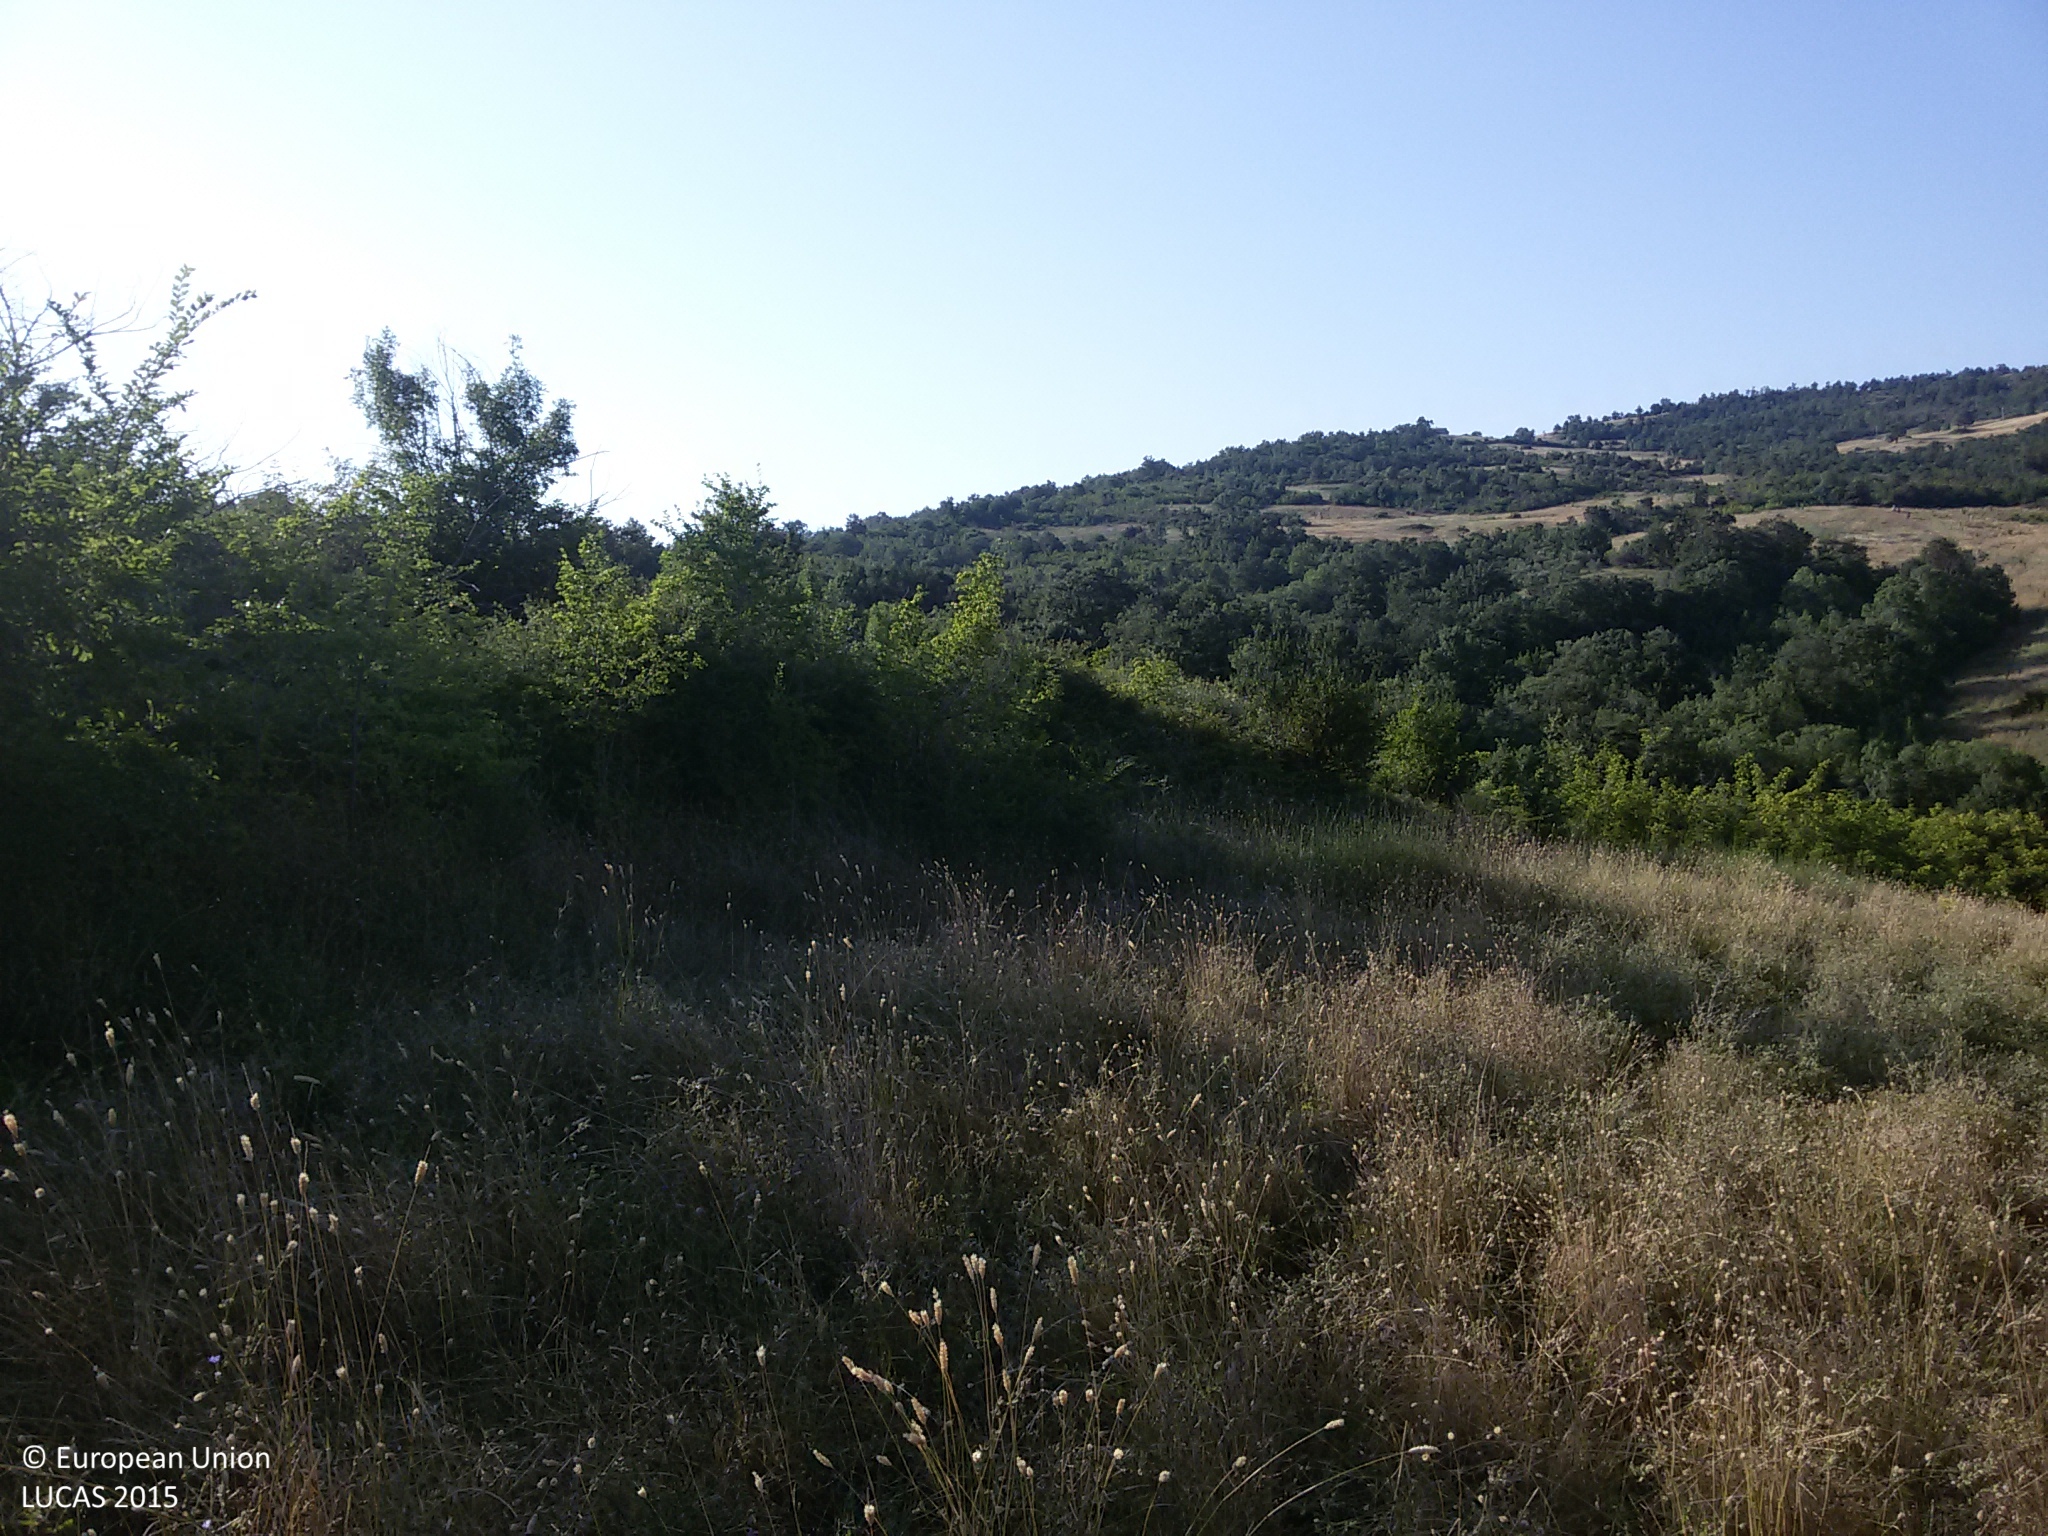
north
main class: Woodland
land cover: Broadleaved woodland
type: thermophilous deciduous forest
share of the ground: > 75 %
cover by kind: broadleaved forest trees 75 %, shrubs 20 %, herbaceous plants 5 %
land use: Forestry
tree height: > 5 m
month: July
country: IT
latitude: 42.7340
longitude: 11.4488
